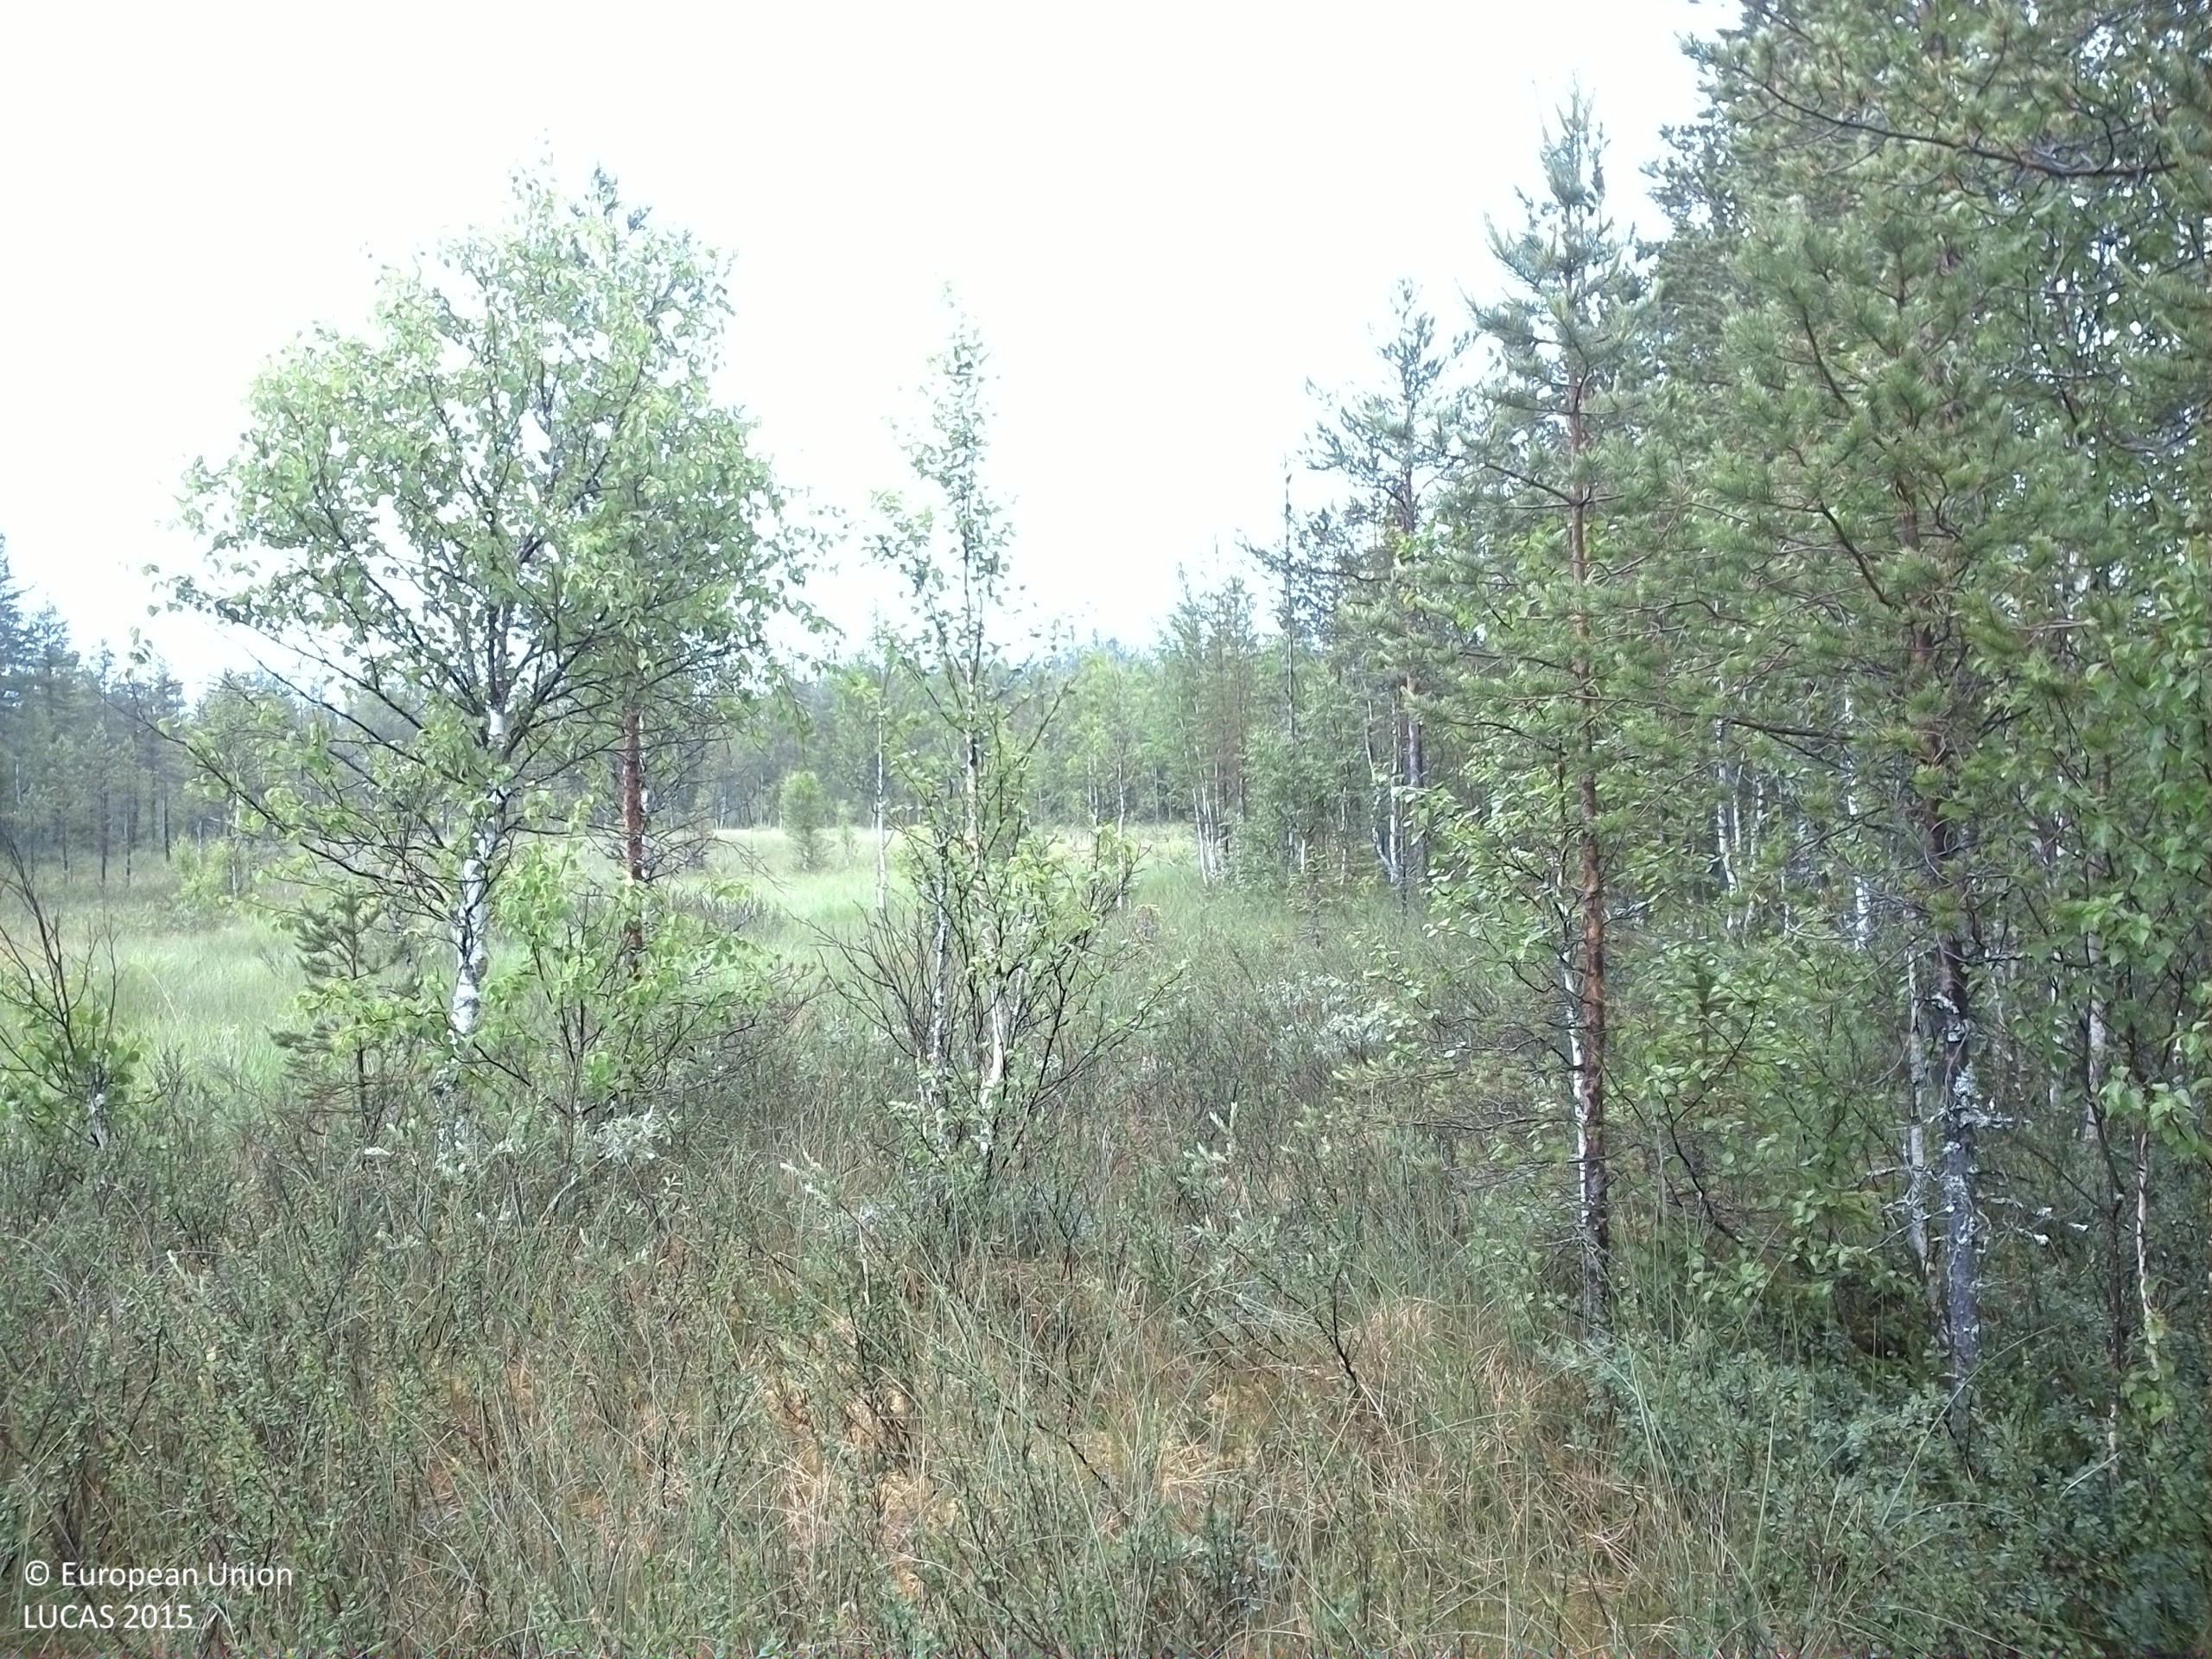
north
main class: Woodland
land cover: Pine dominated mixed woodland
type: boreal forest
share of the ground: 25 - 50 %
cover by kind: shrubs 40 %, lichens and mosses 20 %, coniferous forest trees 15 %, broadleaved forest trees 15 %, herbaceous plants 10 %
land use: Semi-natural and natural areas not in use
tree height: < 5 m
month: July
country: SE
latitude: 63.6656
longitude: 17.3475
